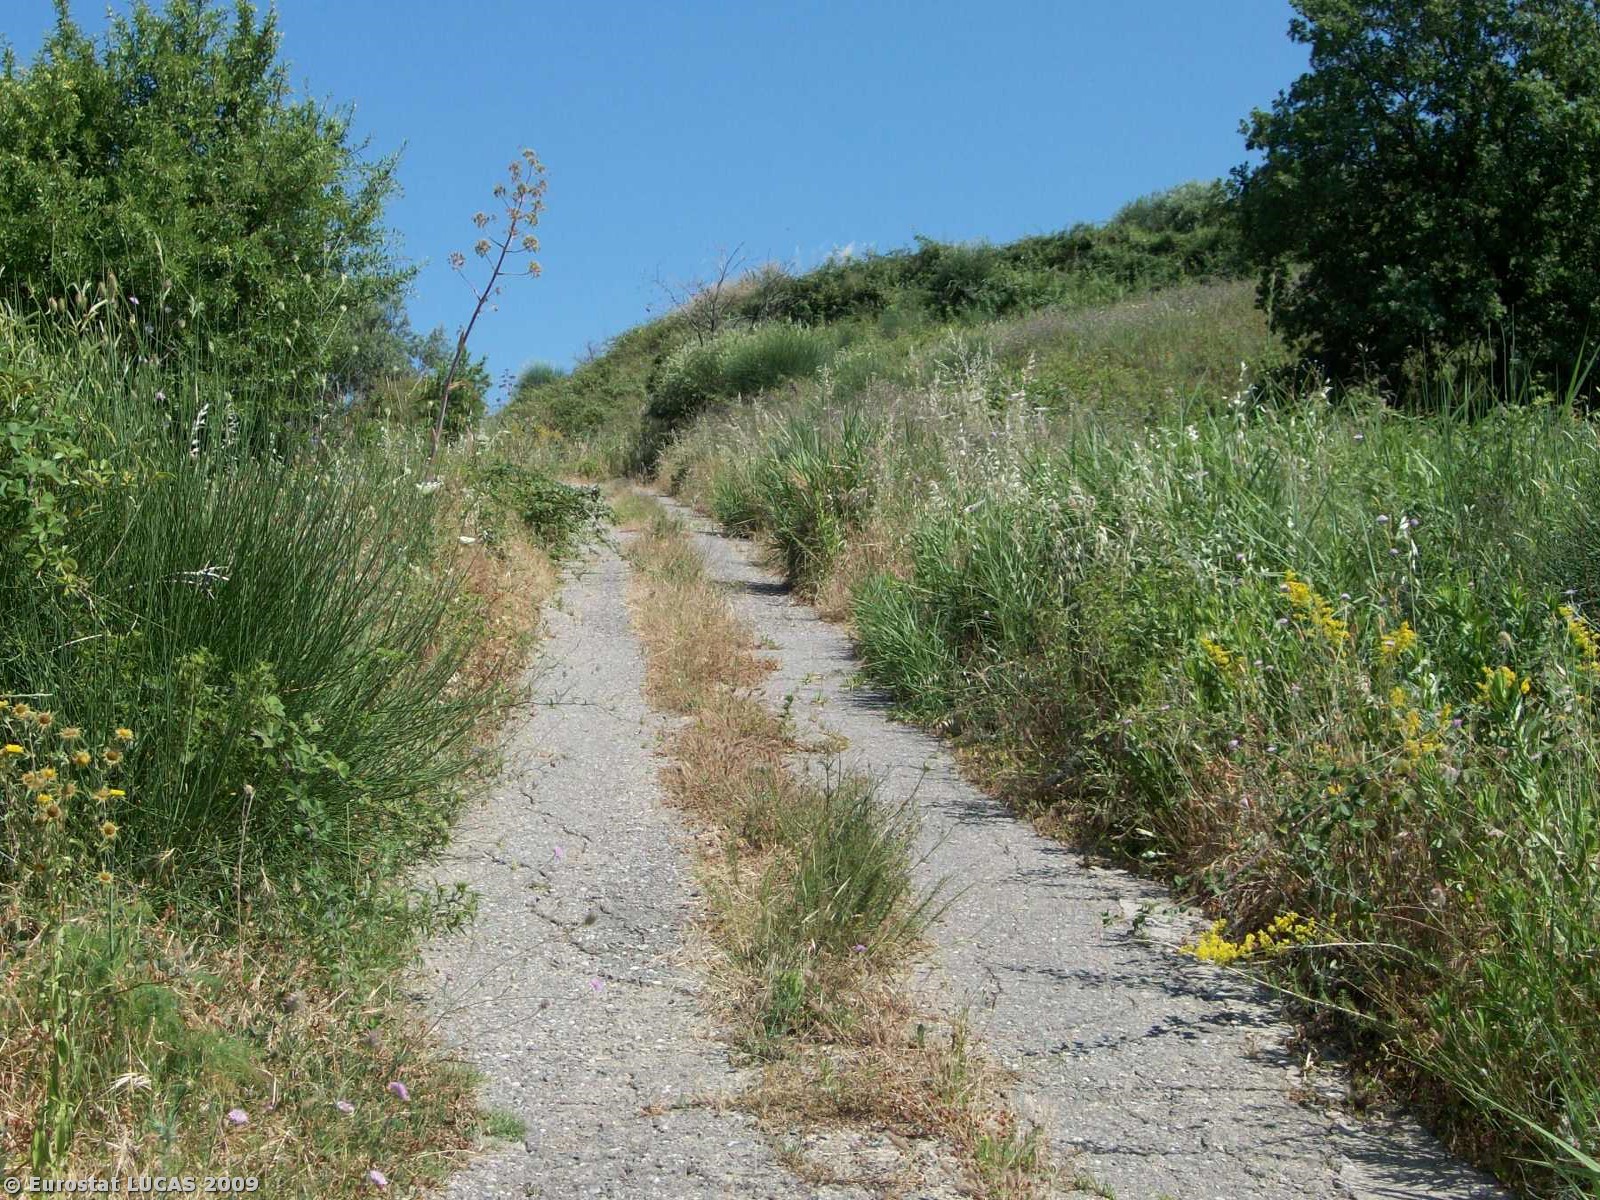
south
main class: Shrubland
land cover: Shrubland with sparse tree cover
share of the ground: > 75 %
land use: Unused
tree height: > 5 m
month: June
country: IT
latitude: 39.4966
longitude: 16.9115
